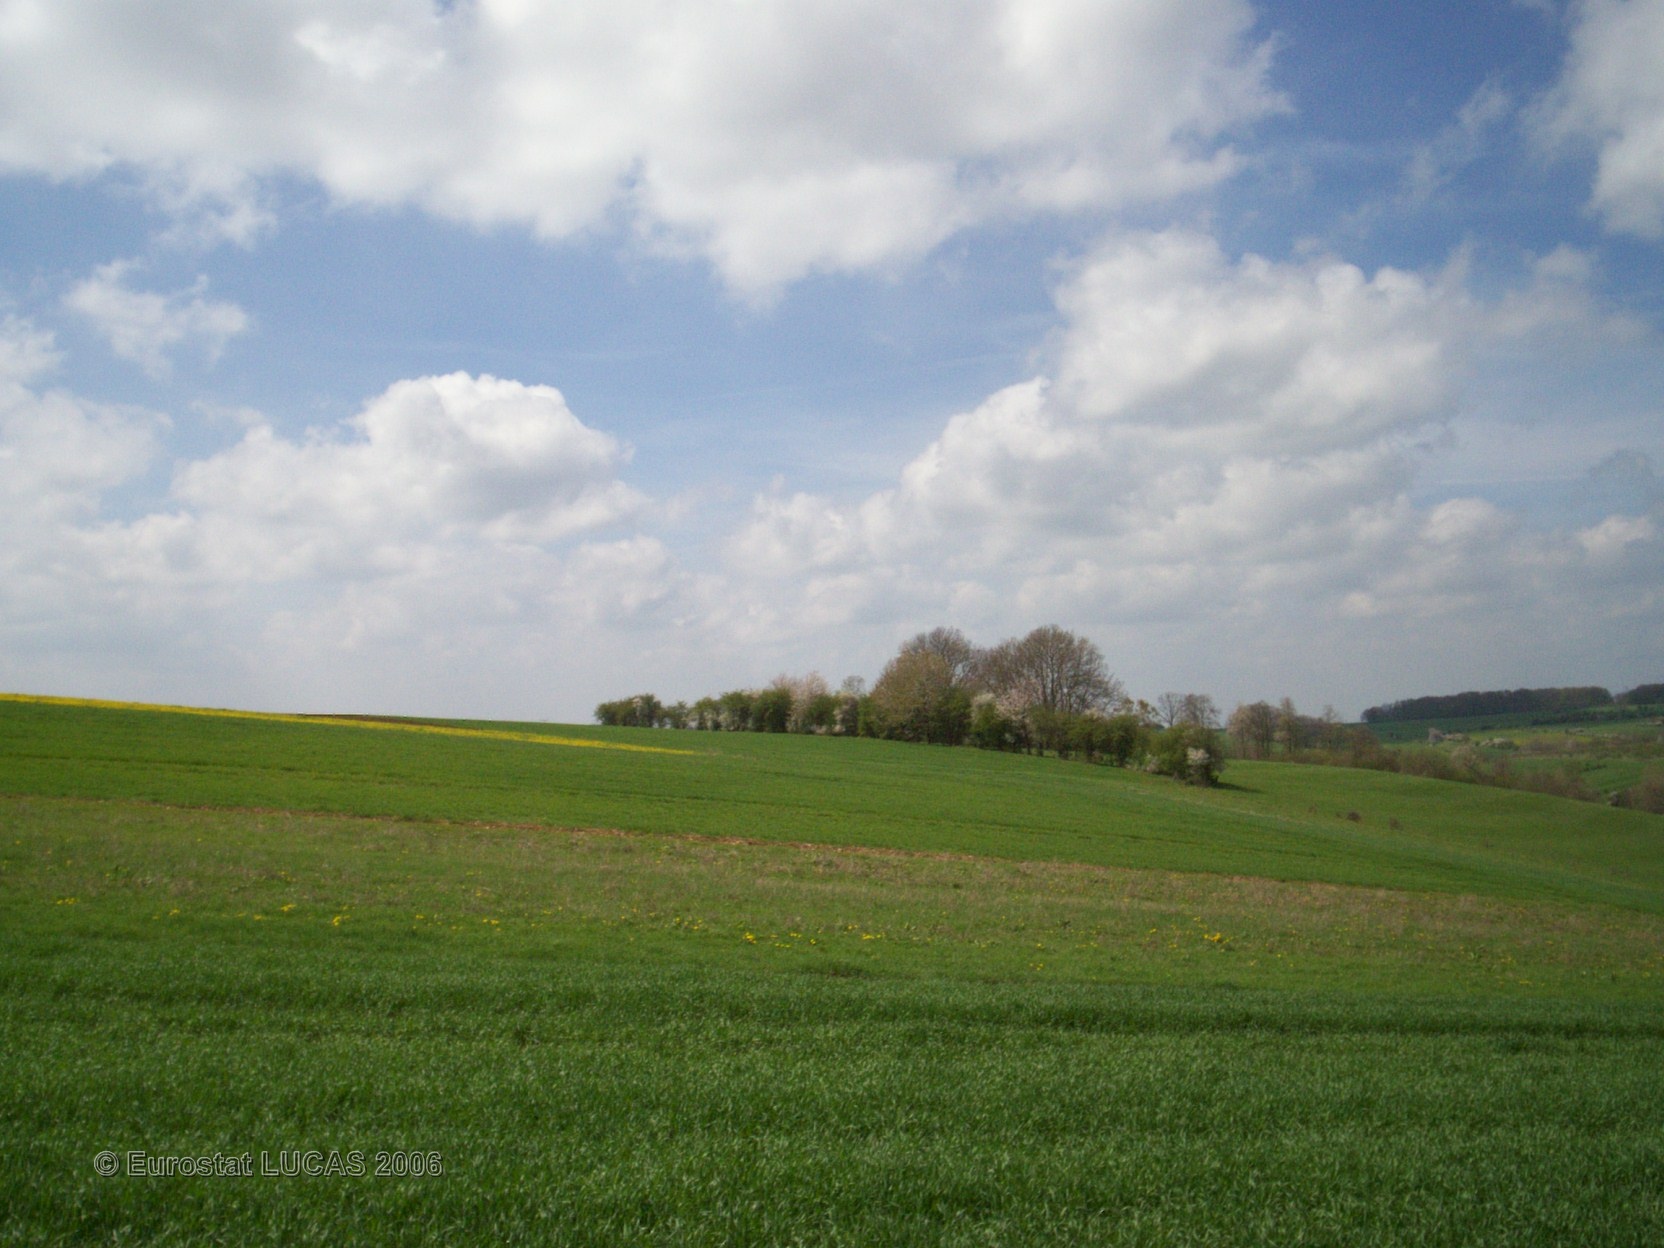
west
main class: Cropland
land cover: Common wheat
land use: Agriculture (excluding fallow land and kitchen gardens)
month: May
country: FR
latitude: 49.8121
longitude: 4.3953
